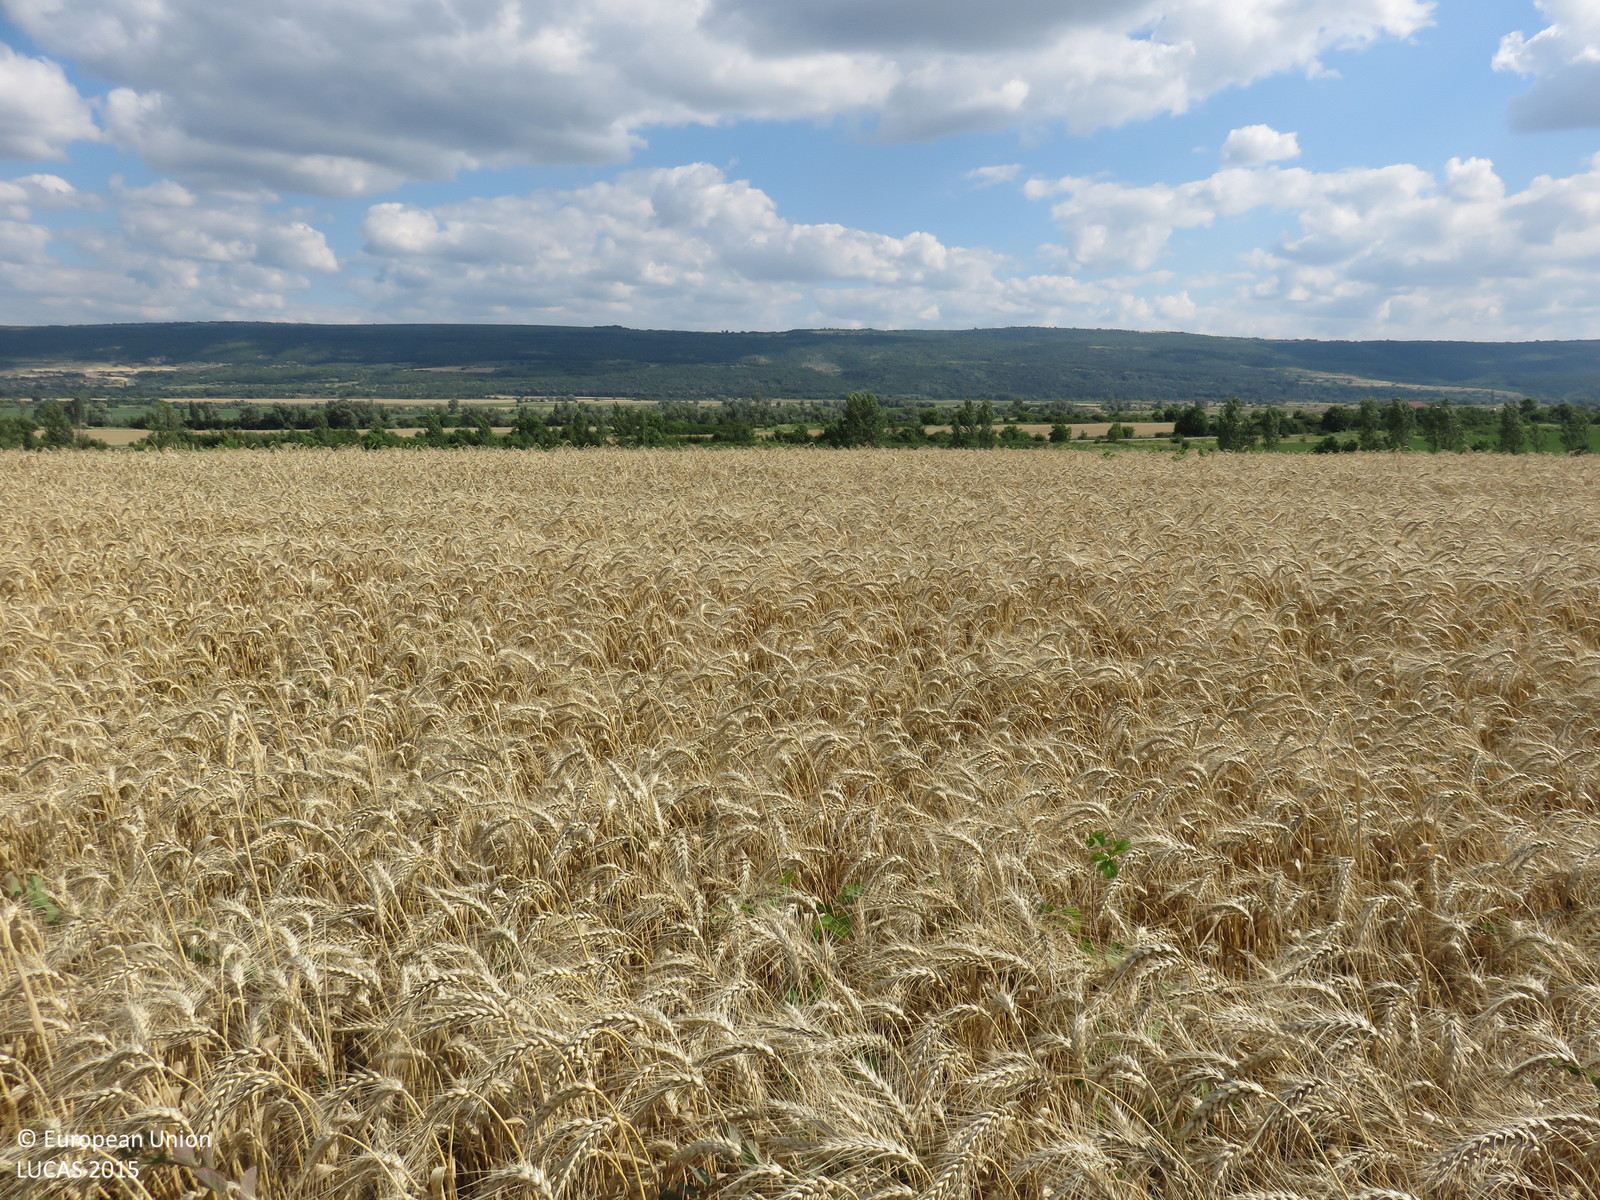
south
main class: Cropland
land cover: Common wheat
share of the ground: > 75 %
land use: Agriculture (excluding fallow land and kitchen gardens)
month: June
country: BG
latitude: 43.2763
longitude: 24.9656
